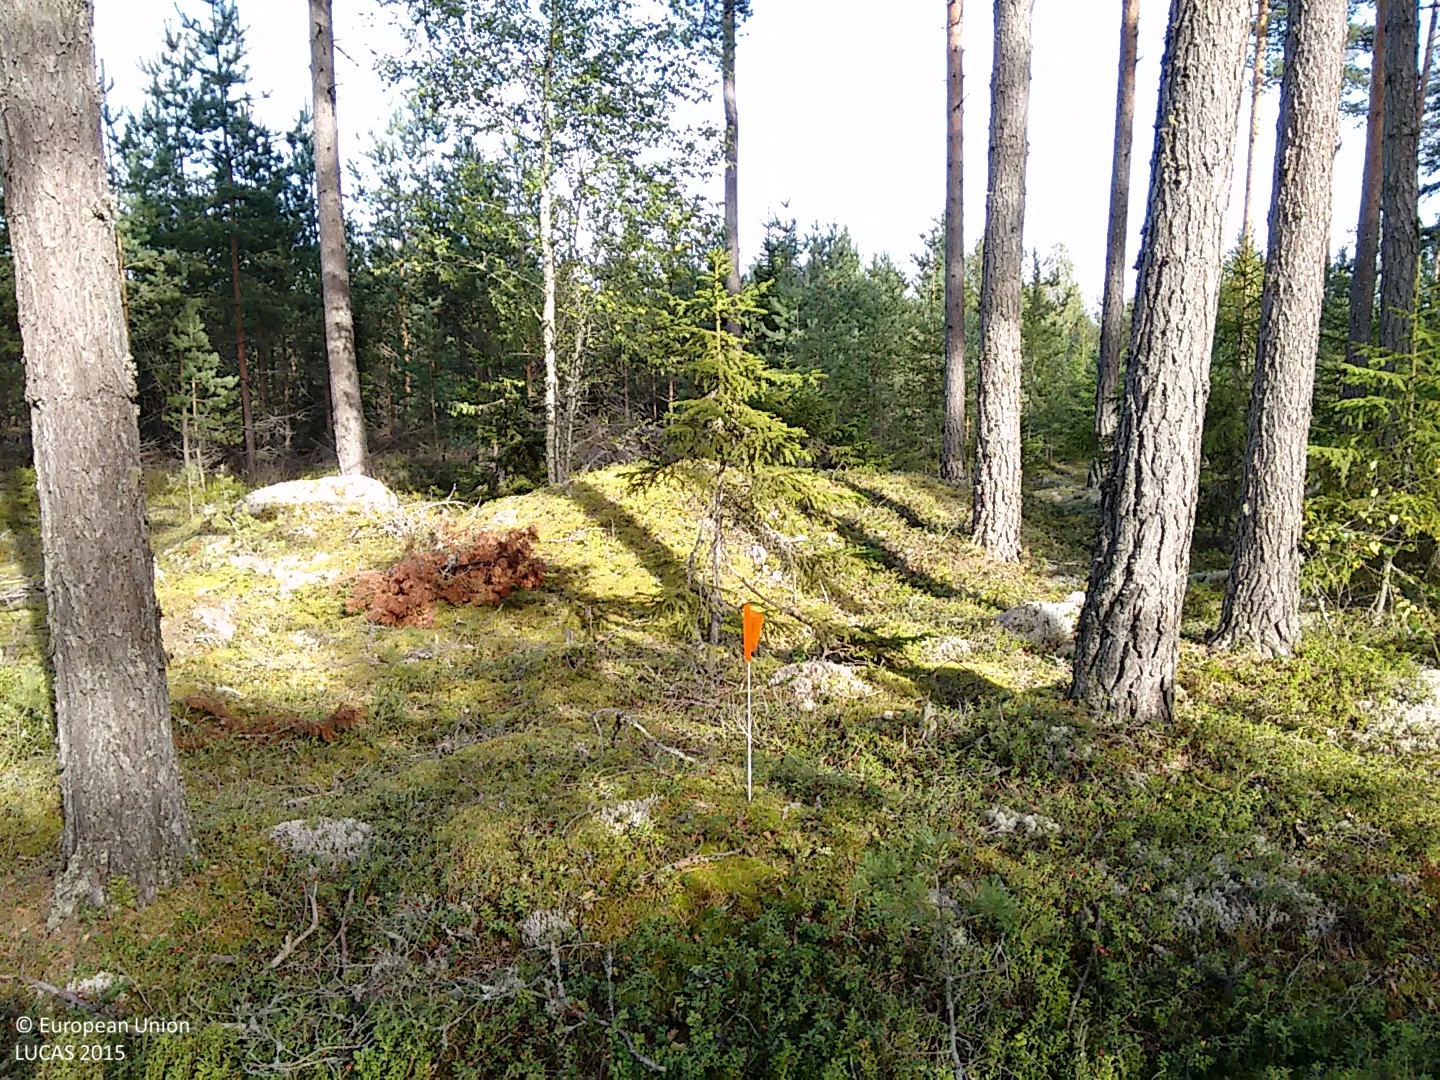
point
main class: Woodland
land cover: Pine dominated coniferous woodland
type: hemiboreal forest and nemoral coniferous forest and mixed broadleaved-coniferous forest
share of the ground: 50 - 75 %
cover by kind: coniferous forest trees 70 %, shrubs 30 %
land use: Forestry
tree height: > 5 m
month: September
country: FI
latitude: 60.8166
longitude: 21.7694
